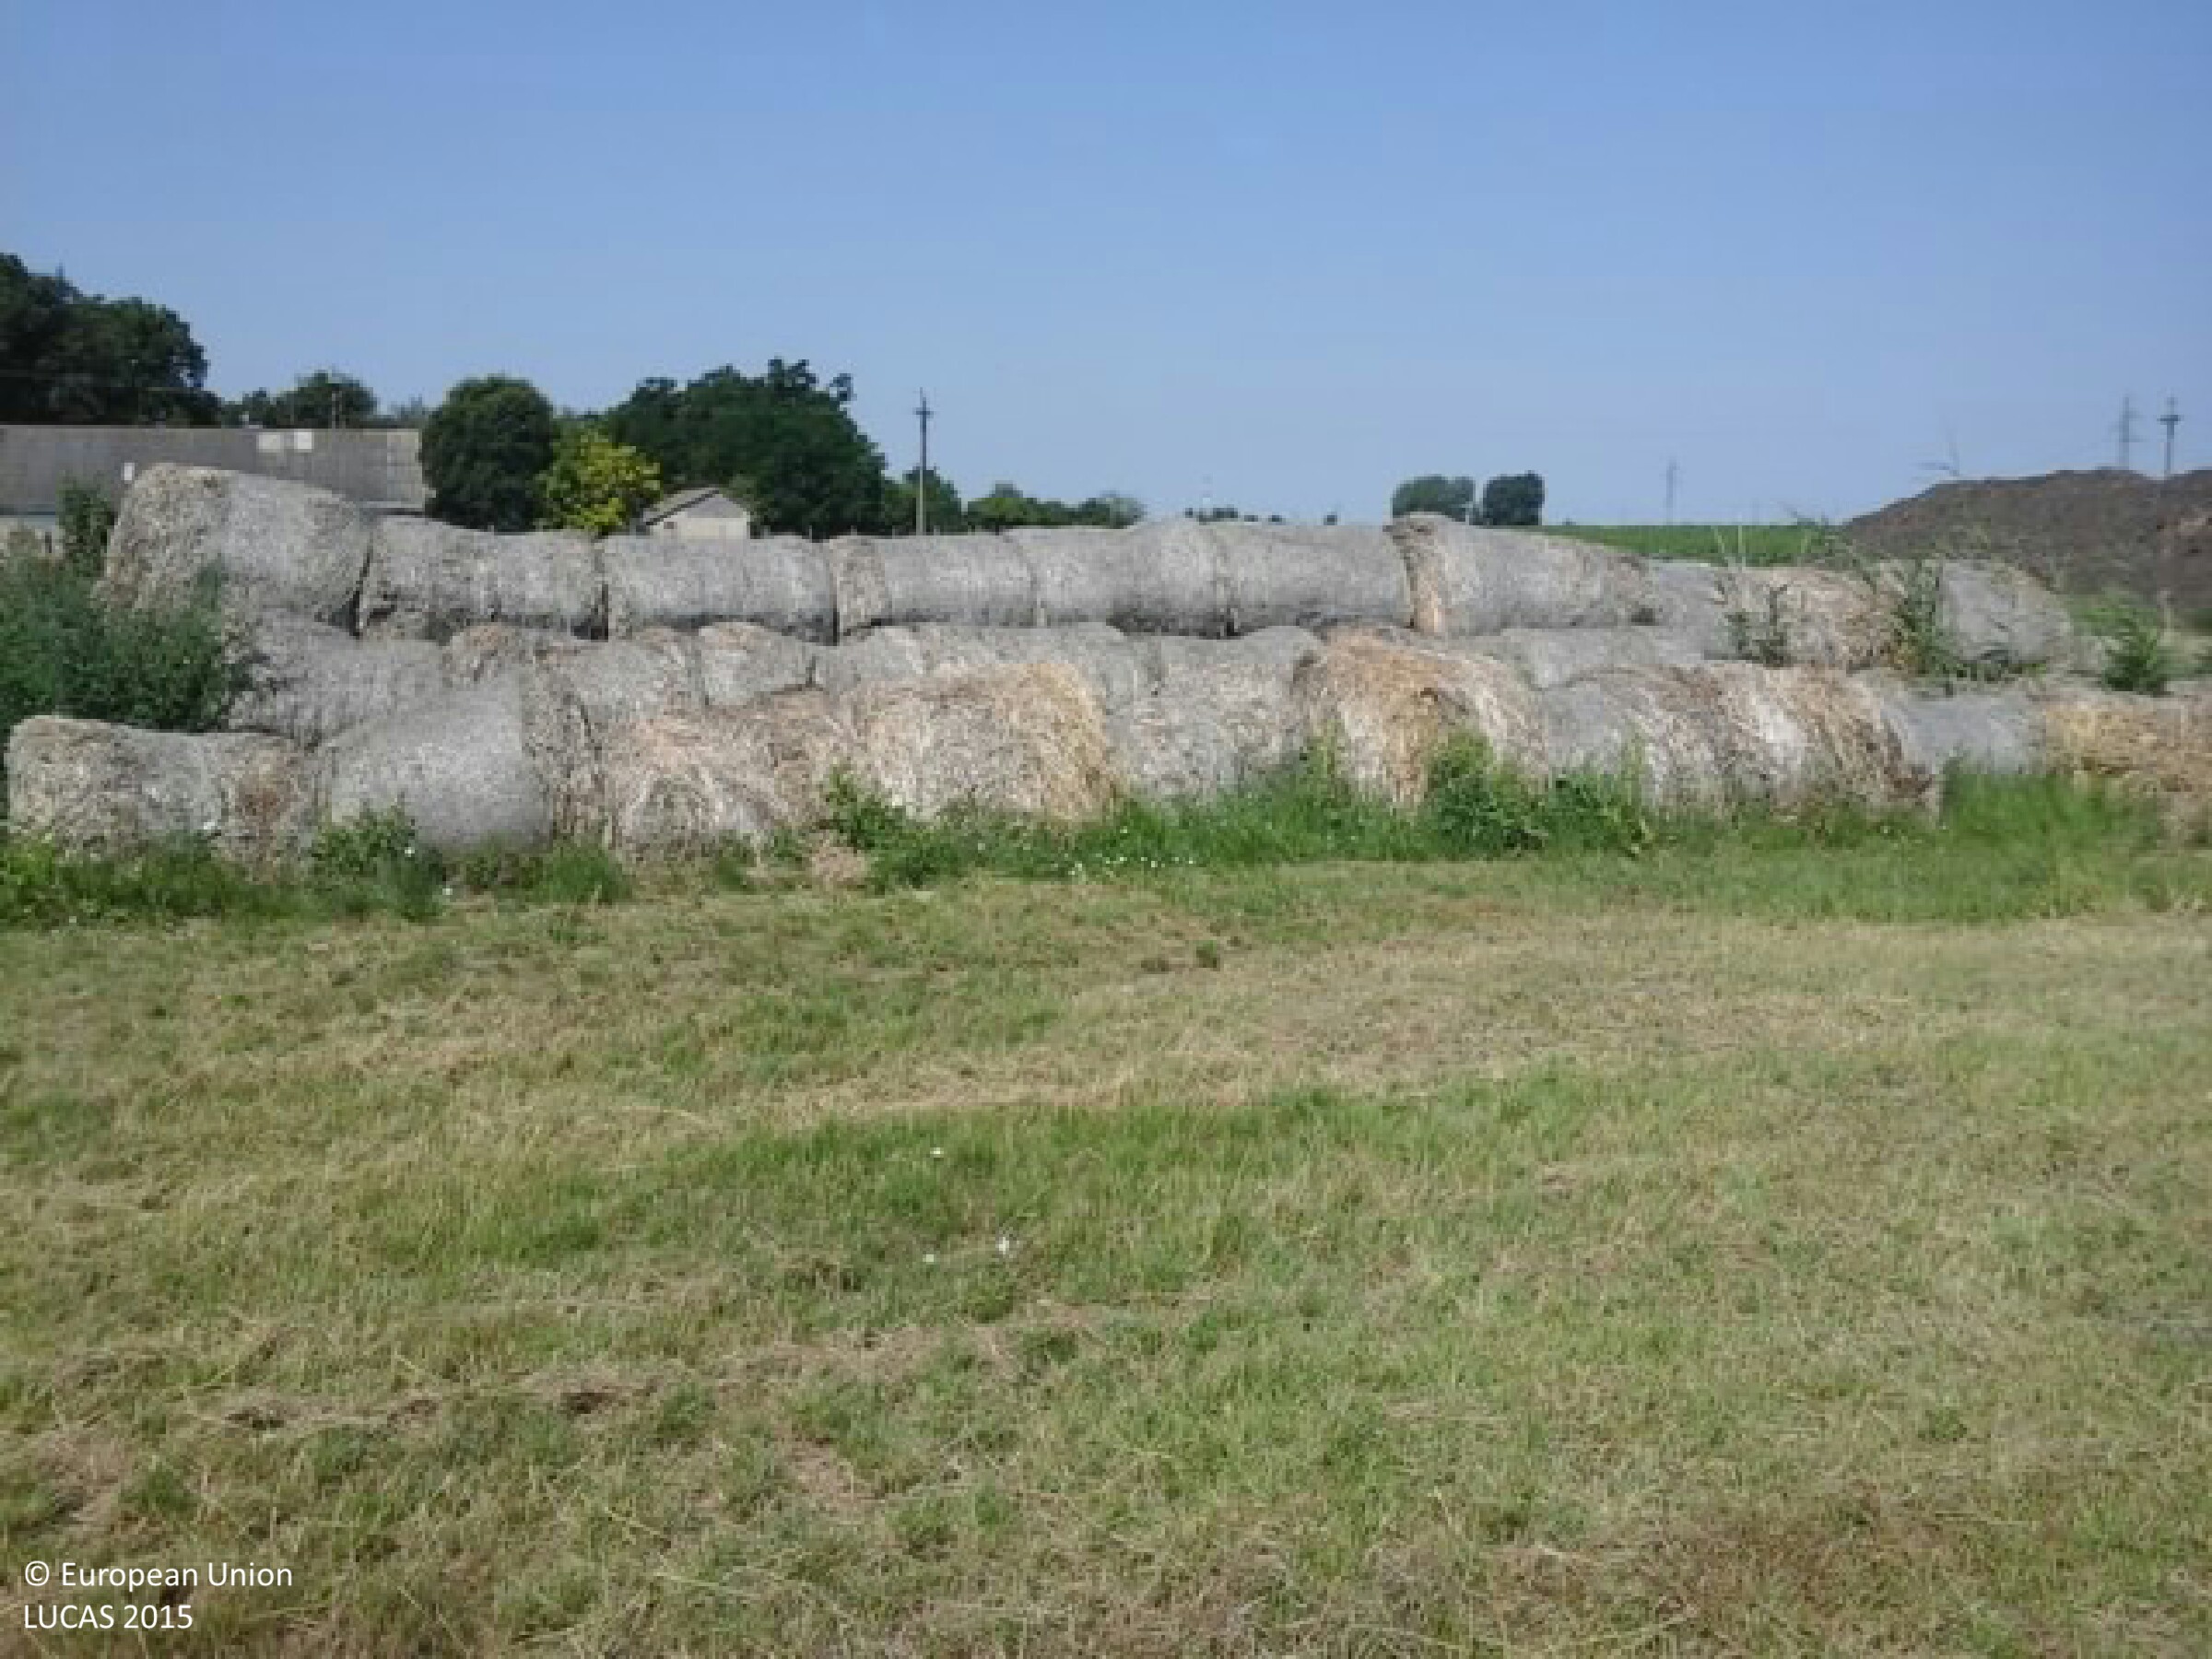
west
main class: Grassland
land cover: Grassland without tree/shrub cover
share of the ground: > 75 %
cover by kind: herbaceous plants 100 %
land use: Agriculture (excluding fallow land and kitchen gardens)
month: July
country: HU
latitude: 46.6657
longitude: 20.3379
